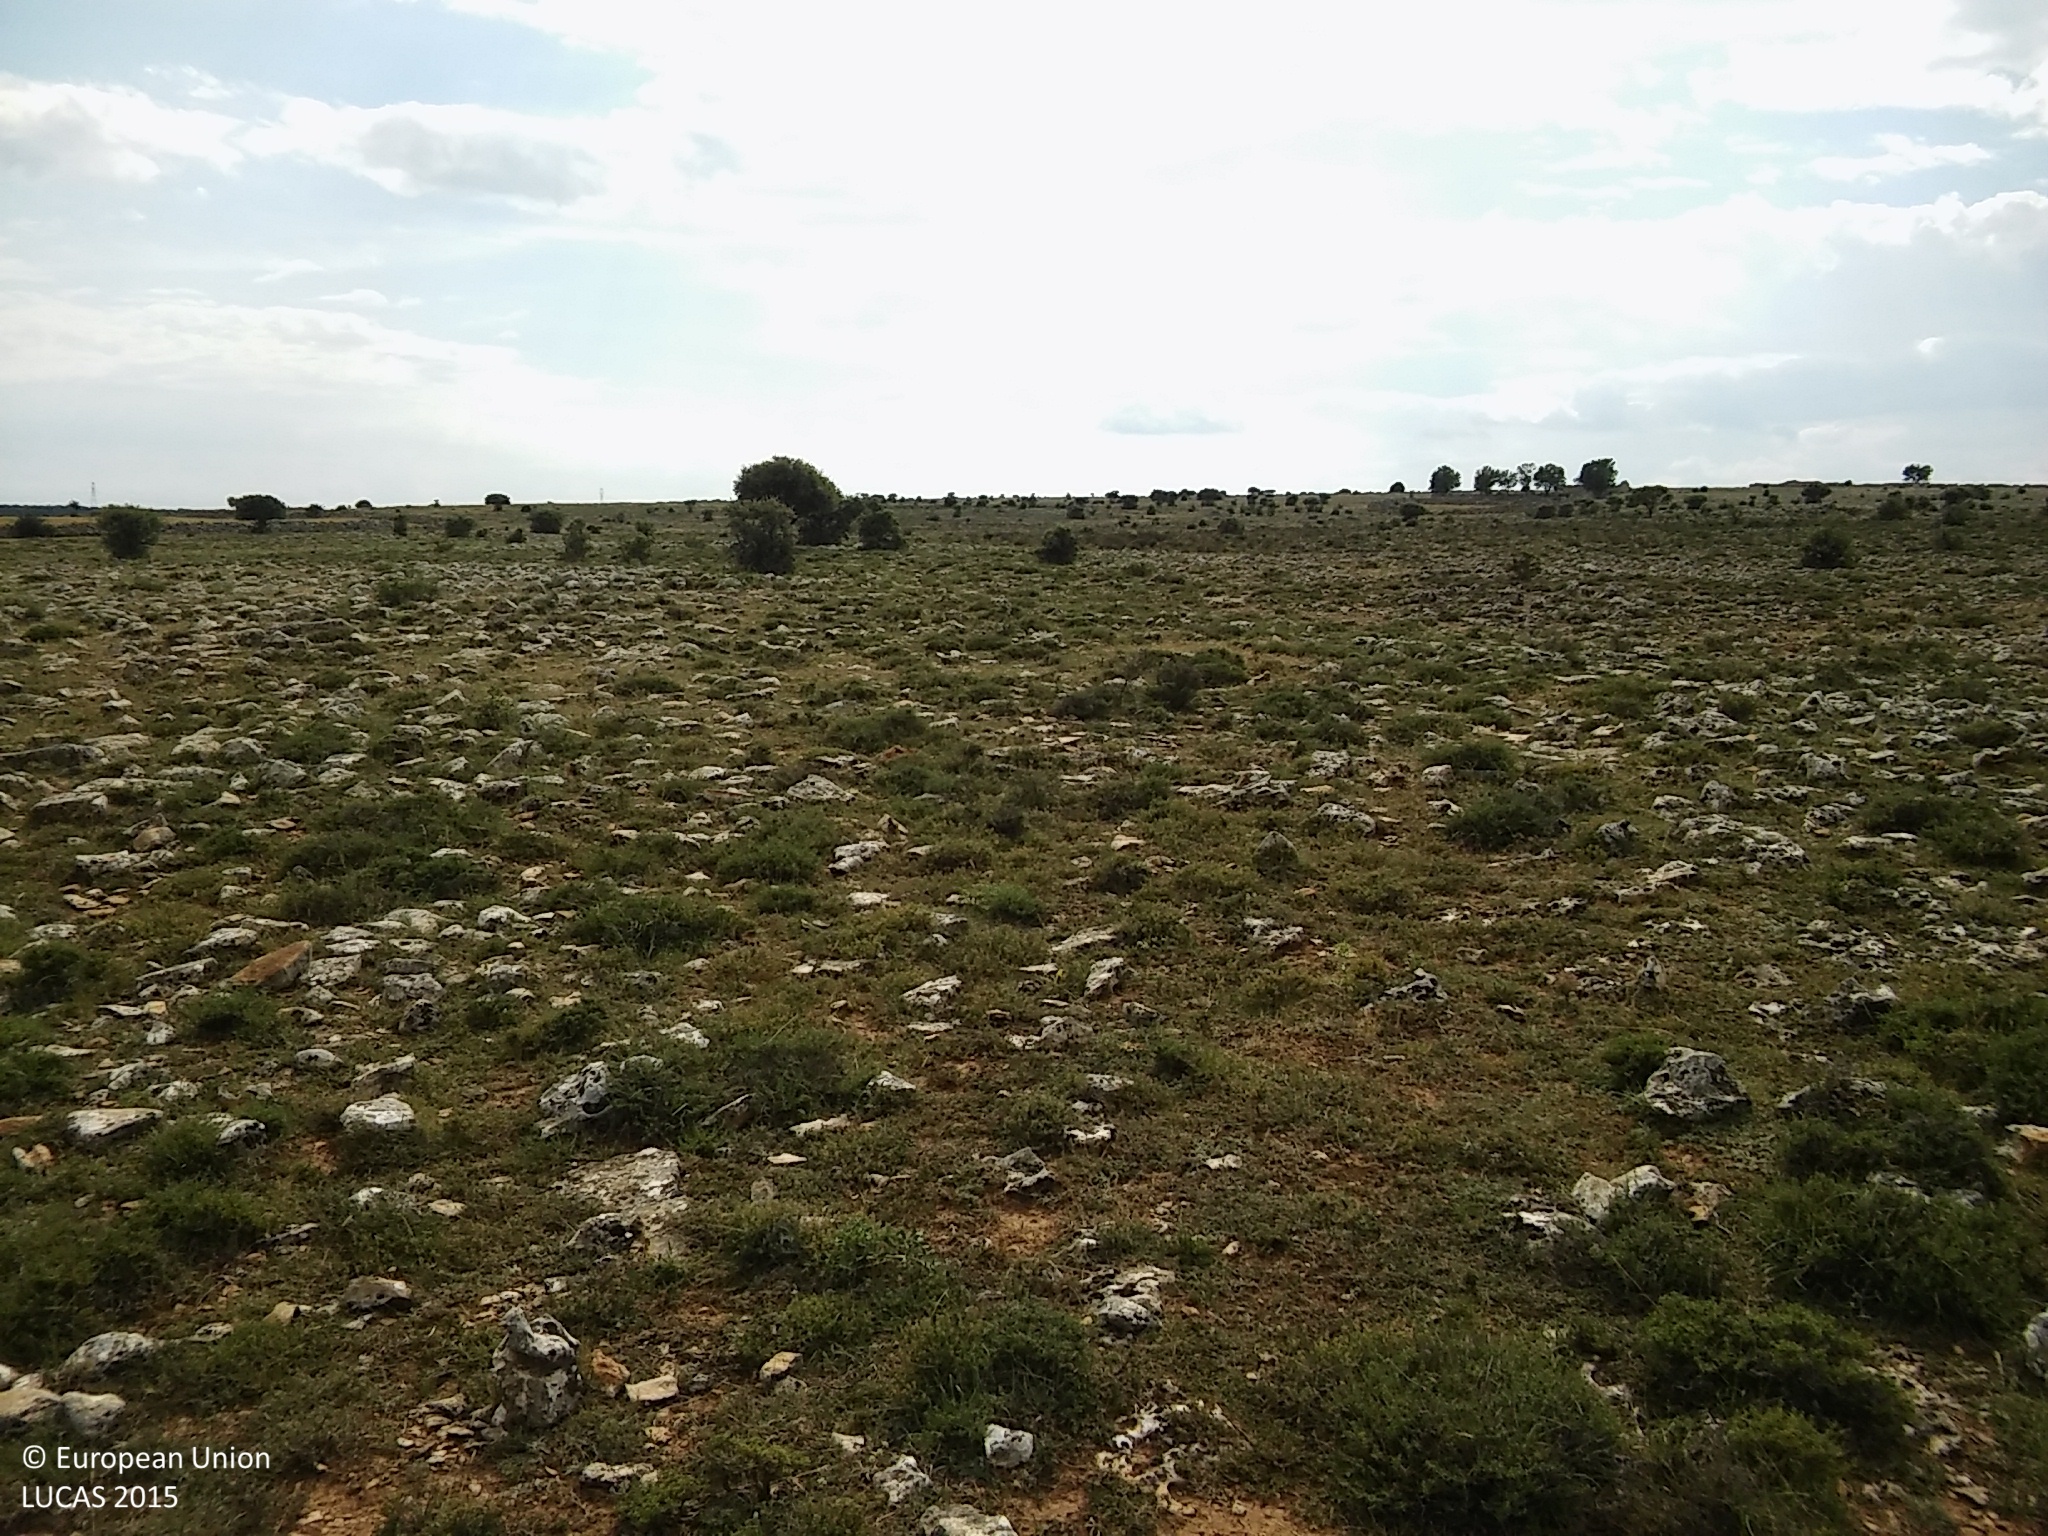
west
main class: Shrubland
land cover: Shrubland without tree cover
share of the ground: 25 - 50 %
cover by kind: unconsolidated bare surface 45 %, herbaceous plants 30 %, shrubs 25 %
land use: Semi-natural and natural areas not in use
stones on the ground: > 50 %
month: June
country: ES
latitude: 41.3475
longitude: -3.7340
